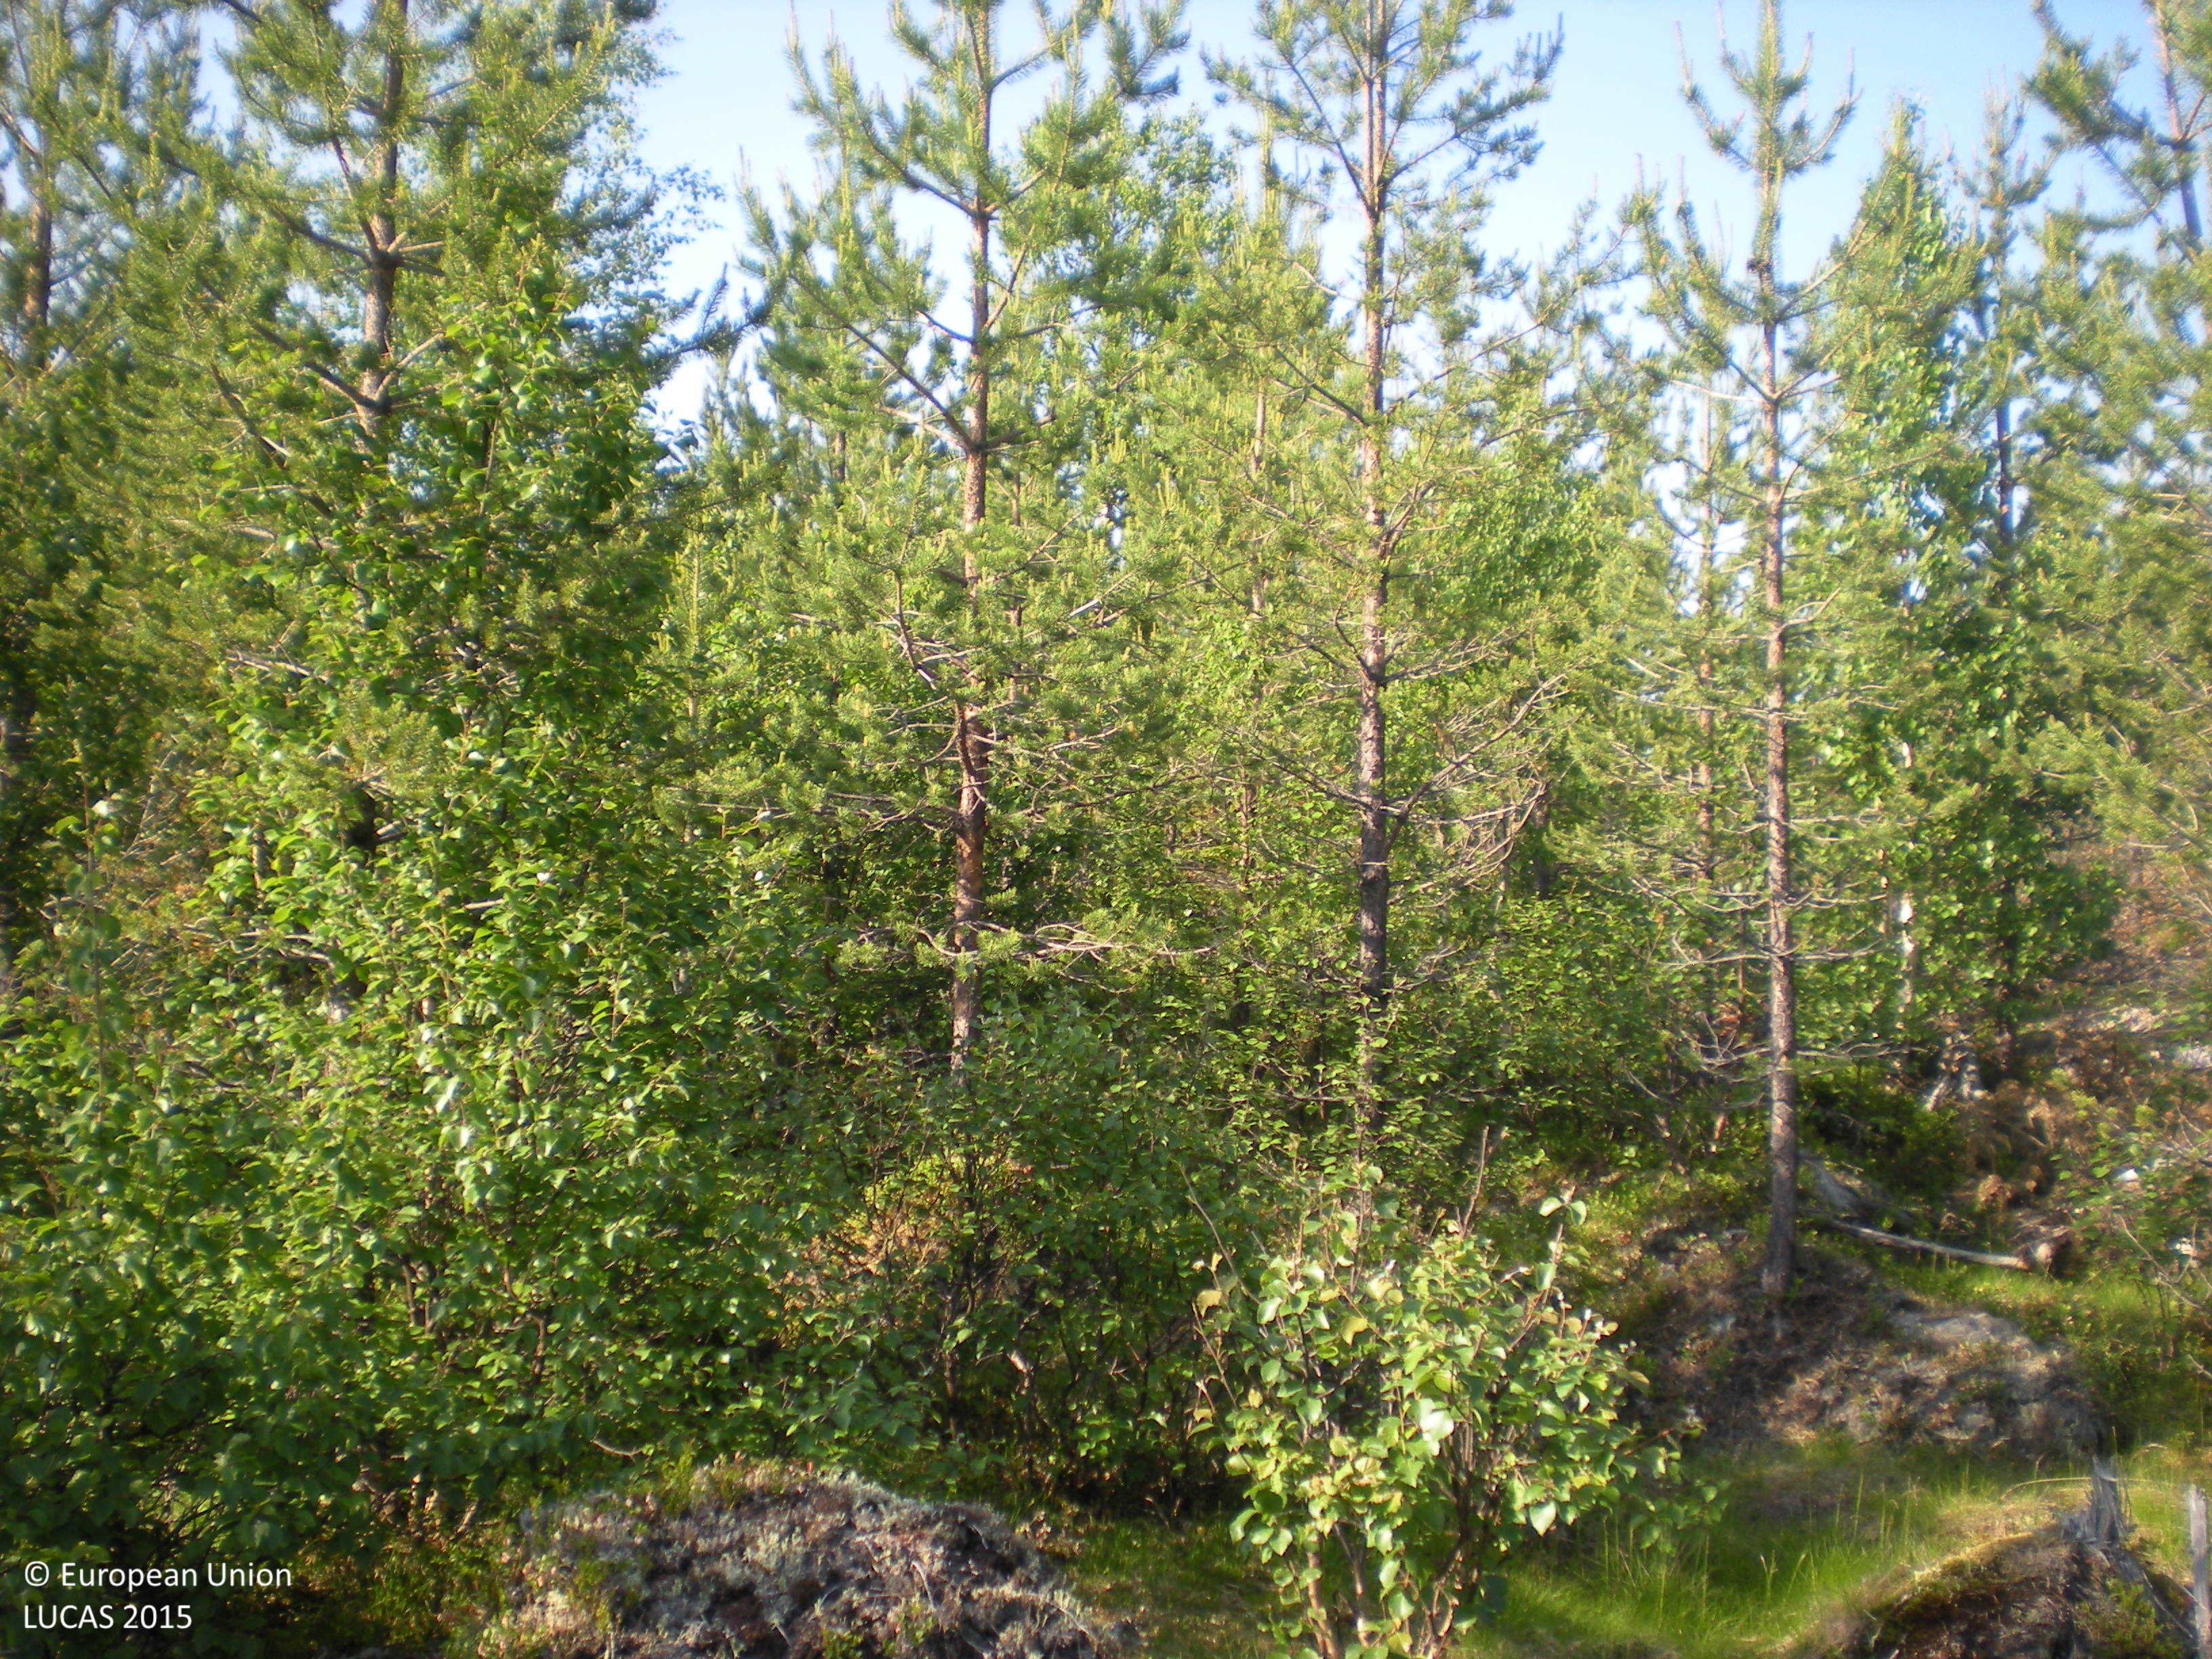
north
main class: Woodland
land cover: Pine dominated mixed woodland
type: boreal forest
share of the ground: 50 - 75 %
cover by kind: coniferous forest trees 30 %, herbaceous plants 30 %, broadleaved forest trees 25 %, shrubs 5 %, lichens and mosses 5 %, consolidated bare surface 5 %
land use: Forestry
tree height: < 5 m
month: July
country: SE
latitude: 65.4841
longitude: 17.6704
